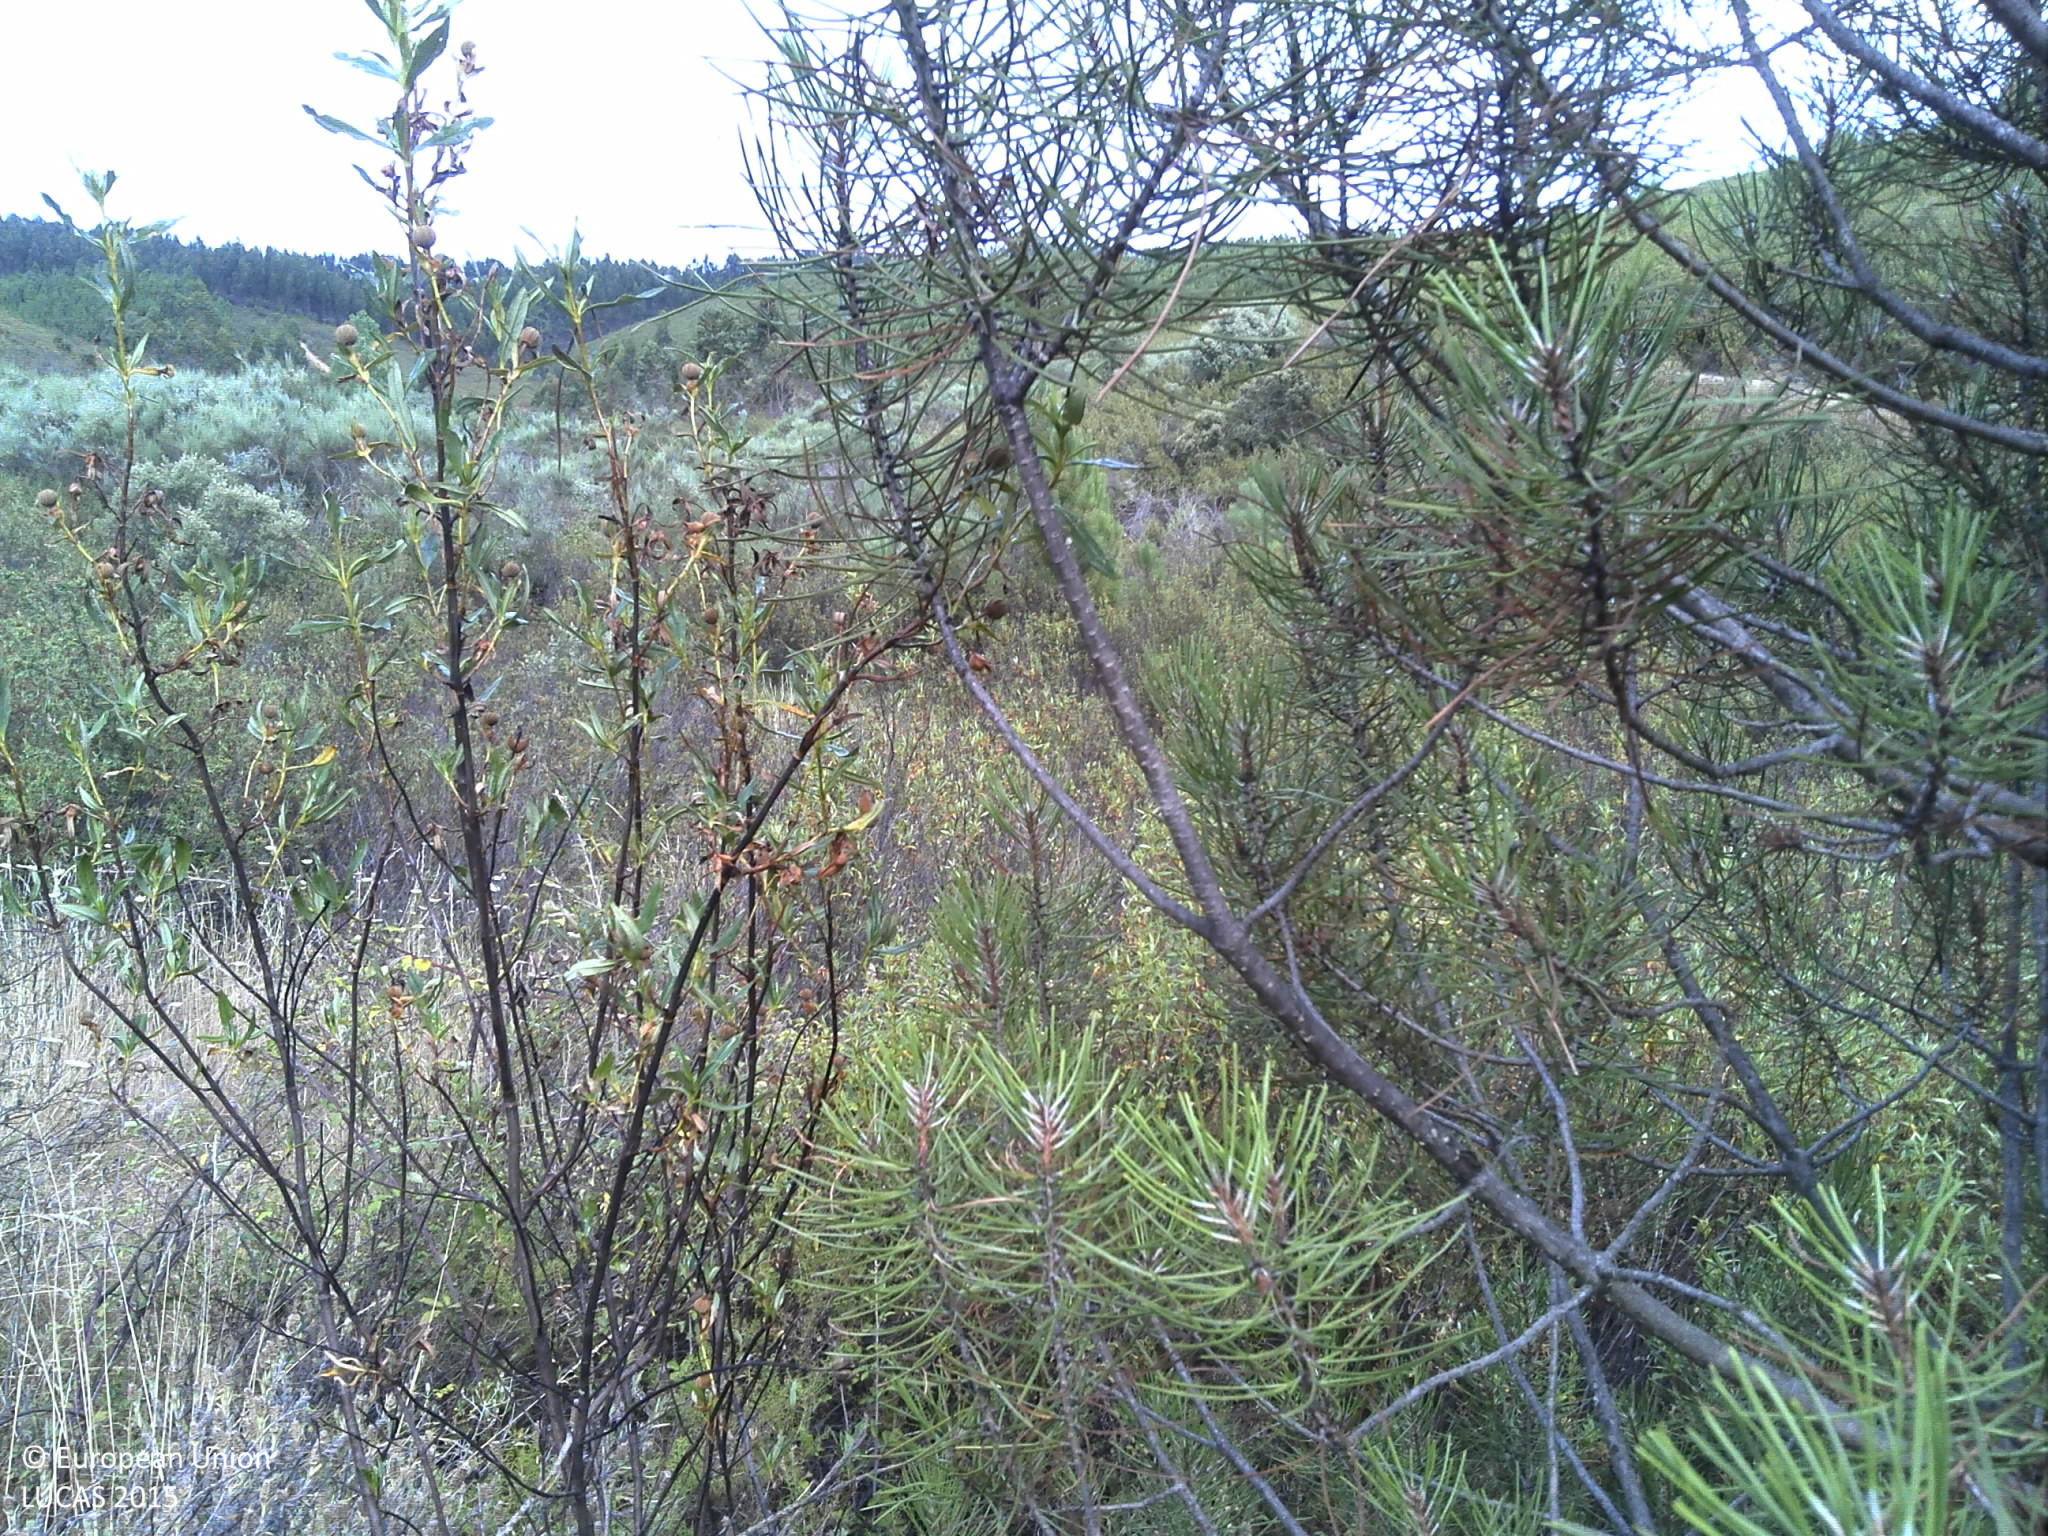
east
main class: Woodland
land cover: Pine dominated coniferous woodland
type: coniferous forest of the mediterranean region
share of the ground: 10 - 25 %
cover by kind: shrubs 60 %, unconsolidated bare surface 25 %, coniferous forest trees 15 %
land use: Forestry
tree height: < 5 m
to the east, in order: Pine dominated coniferous woodland; Shrubland with sparse tree cover; Rivers and streams; Shrubland with sparse tree cover; Tracks; Broadleaved woodland; Tracks; Broadleaved woodland; Tracks; Pine dominated coniferous woodland; Shrubland without tree cover
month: July
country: PT
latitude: 39.6679
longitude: -8.0504
